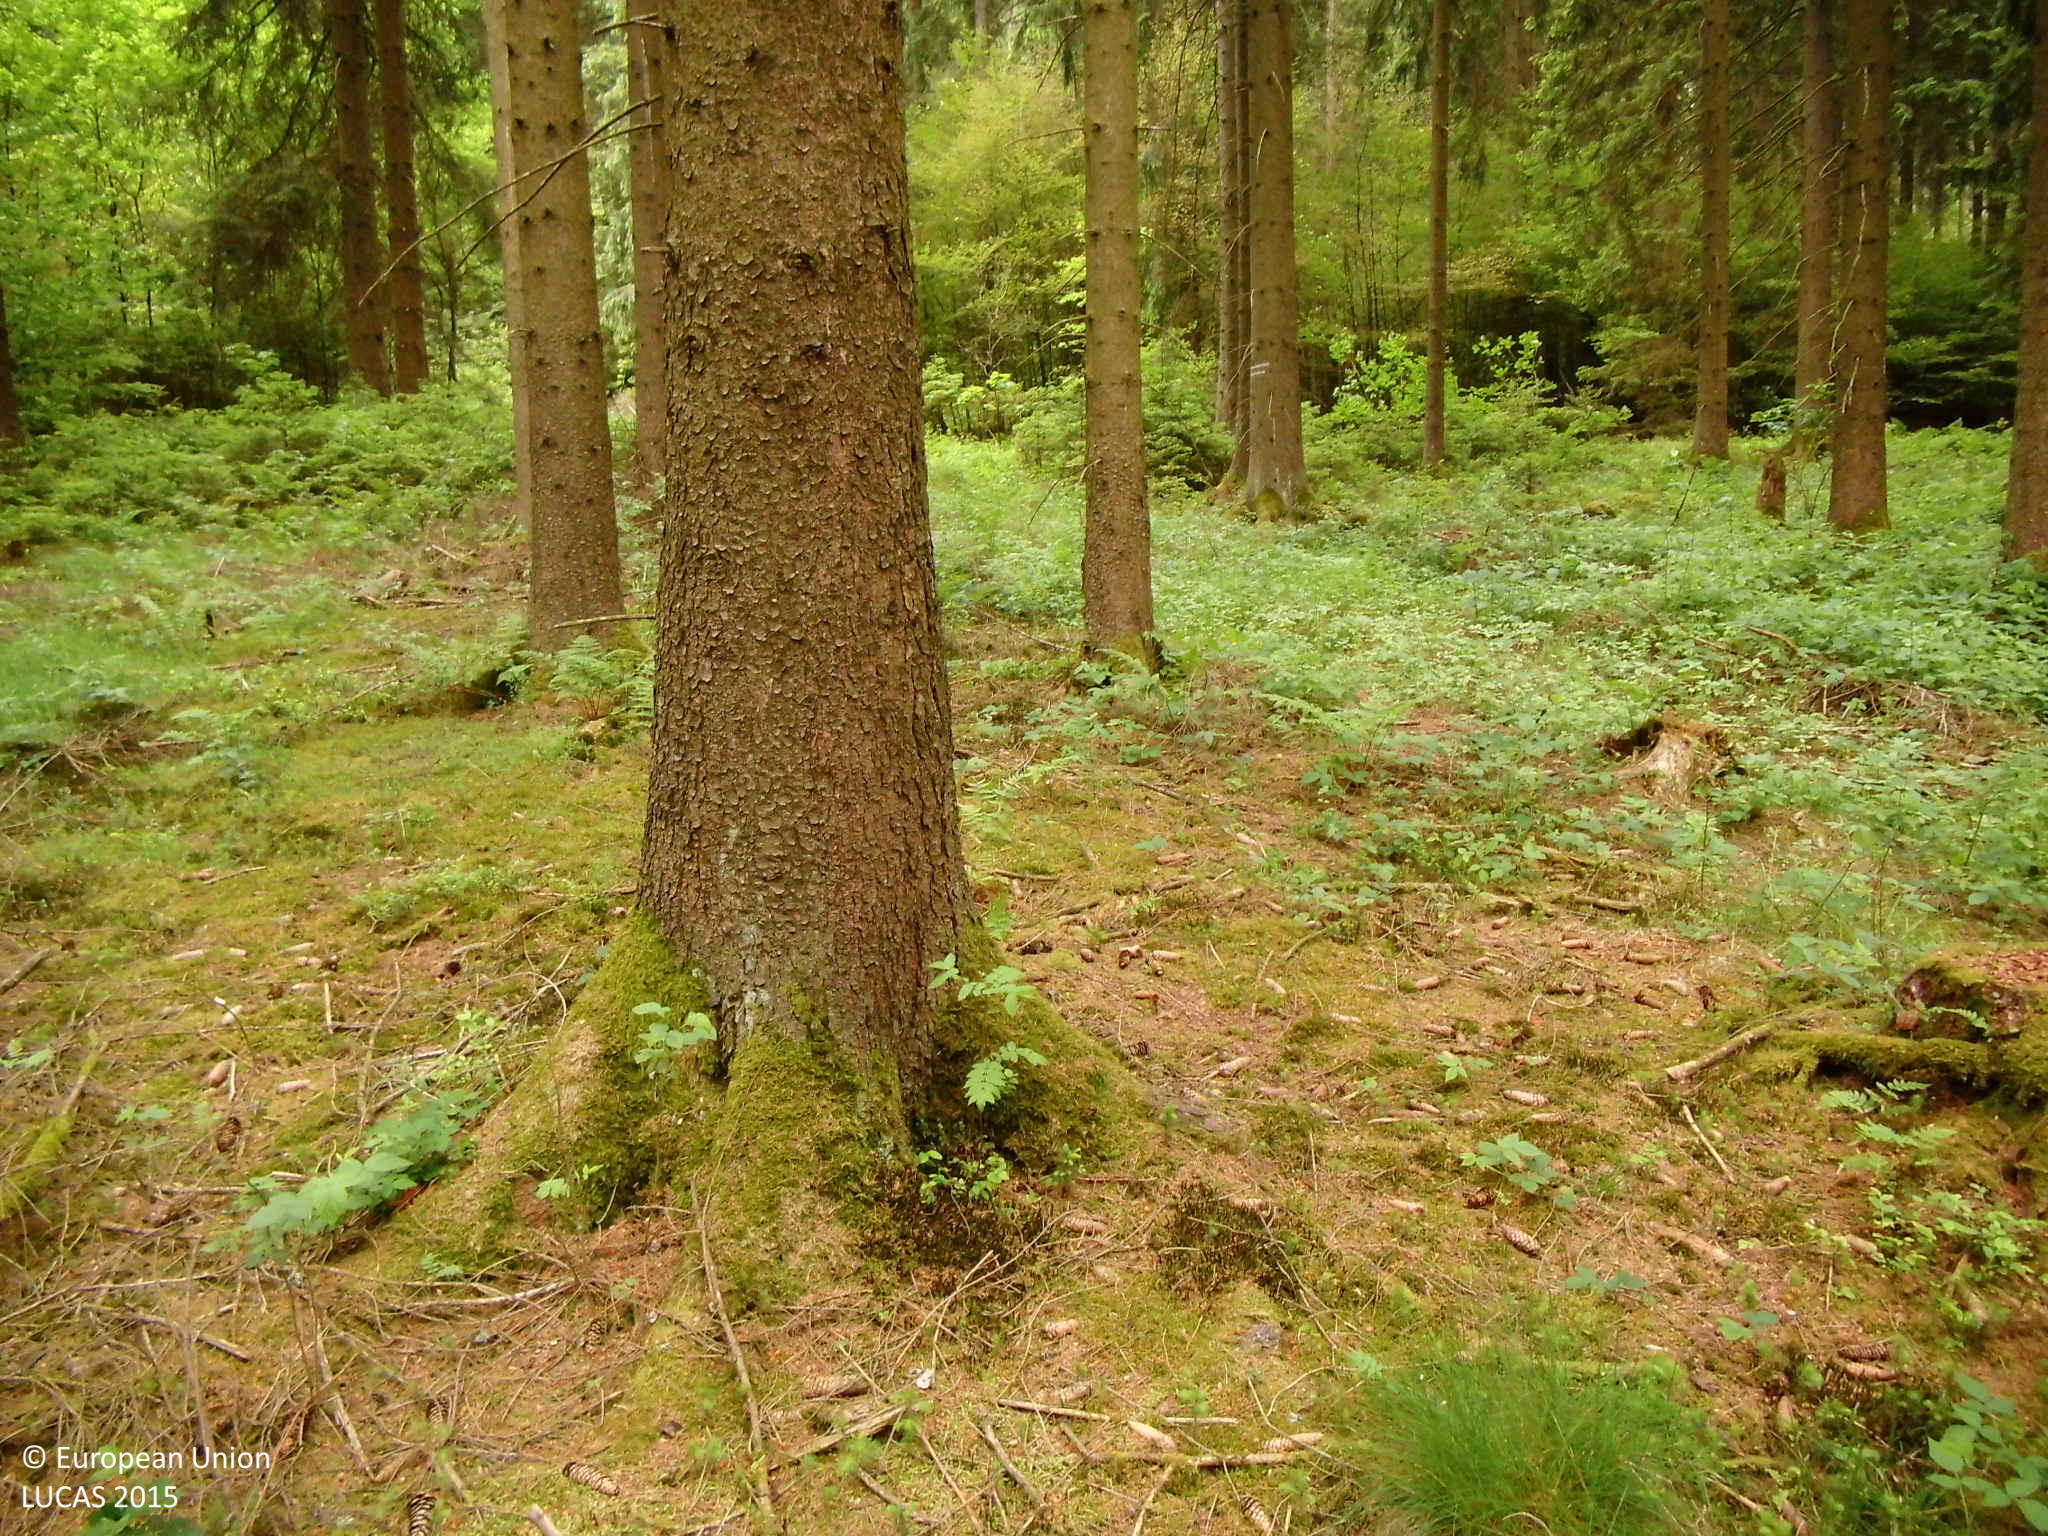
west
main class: Woodland
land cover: Spruce dominated coniferous woodland
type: hemiboreal forest and nemoral coniferous forest and mixed broadleaved-coniferous forest
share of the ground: > 75 %
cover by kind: coniferous forest trees 75 %, shrubs 10 %, lichens and mosses 10 %, herbaceous plants 5 %
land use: Forestry
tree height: > 5 m
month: June
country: DE
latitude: 51.0488
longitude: 8.0461
